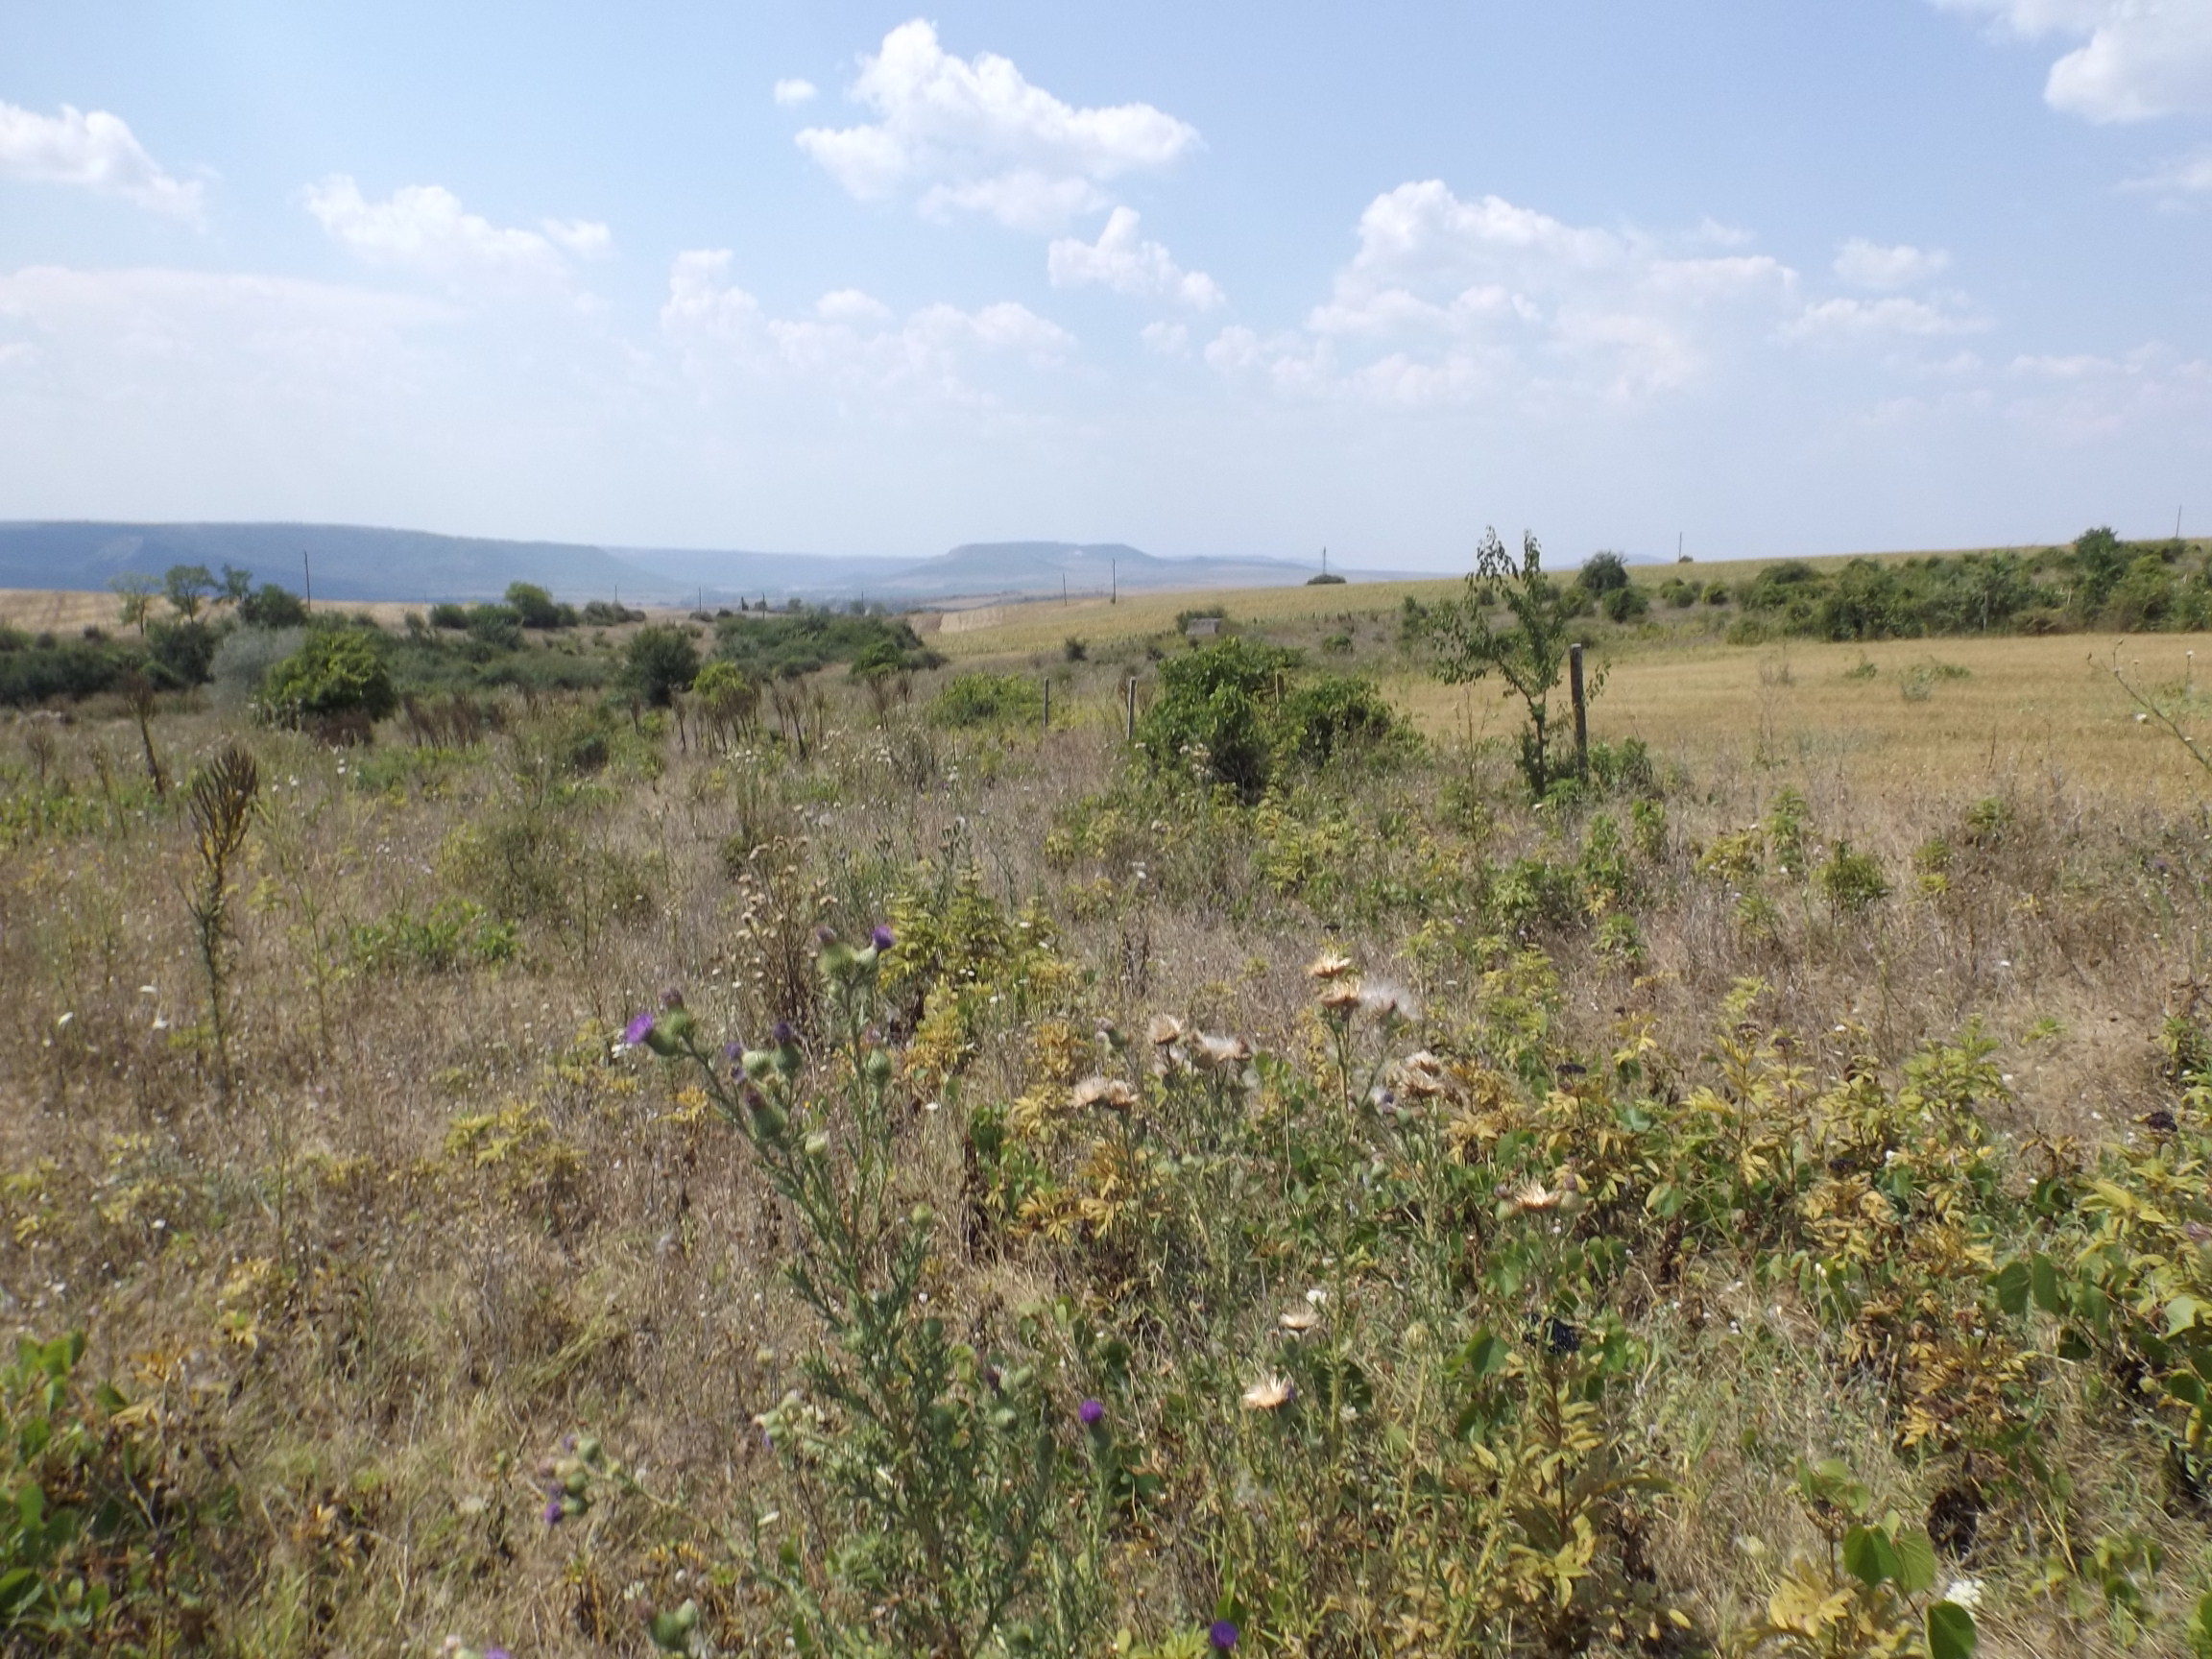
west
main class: Grassland
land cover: Spontaneously vegetated surfaces
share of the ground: > 75 %
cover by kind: herbaceous plants 95 %, shrubs 5 %
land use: Semi-natural and natural areas not in use
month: August
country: BG
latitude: 43.2398
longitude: 27.4786
